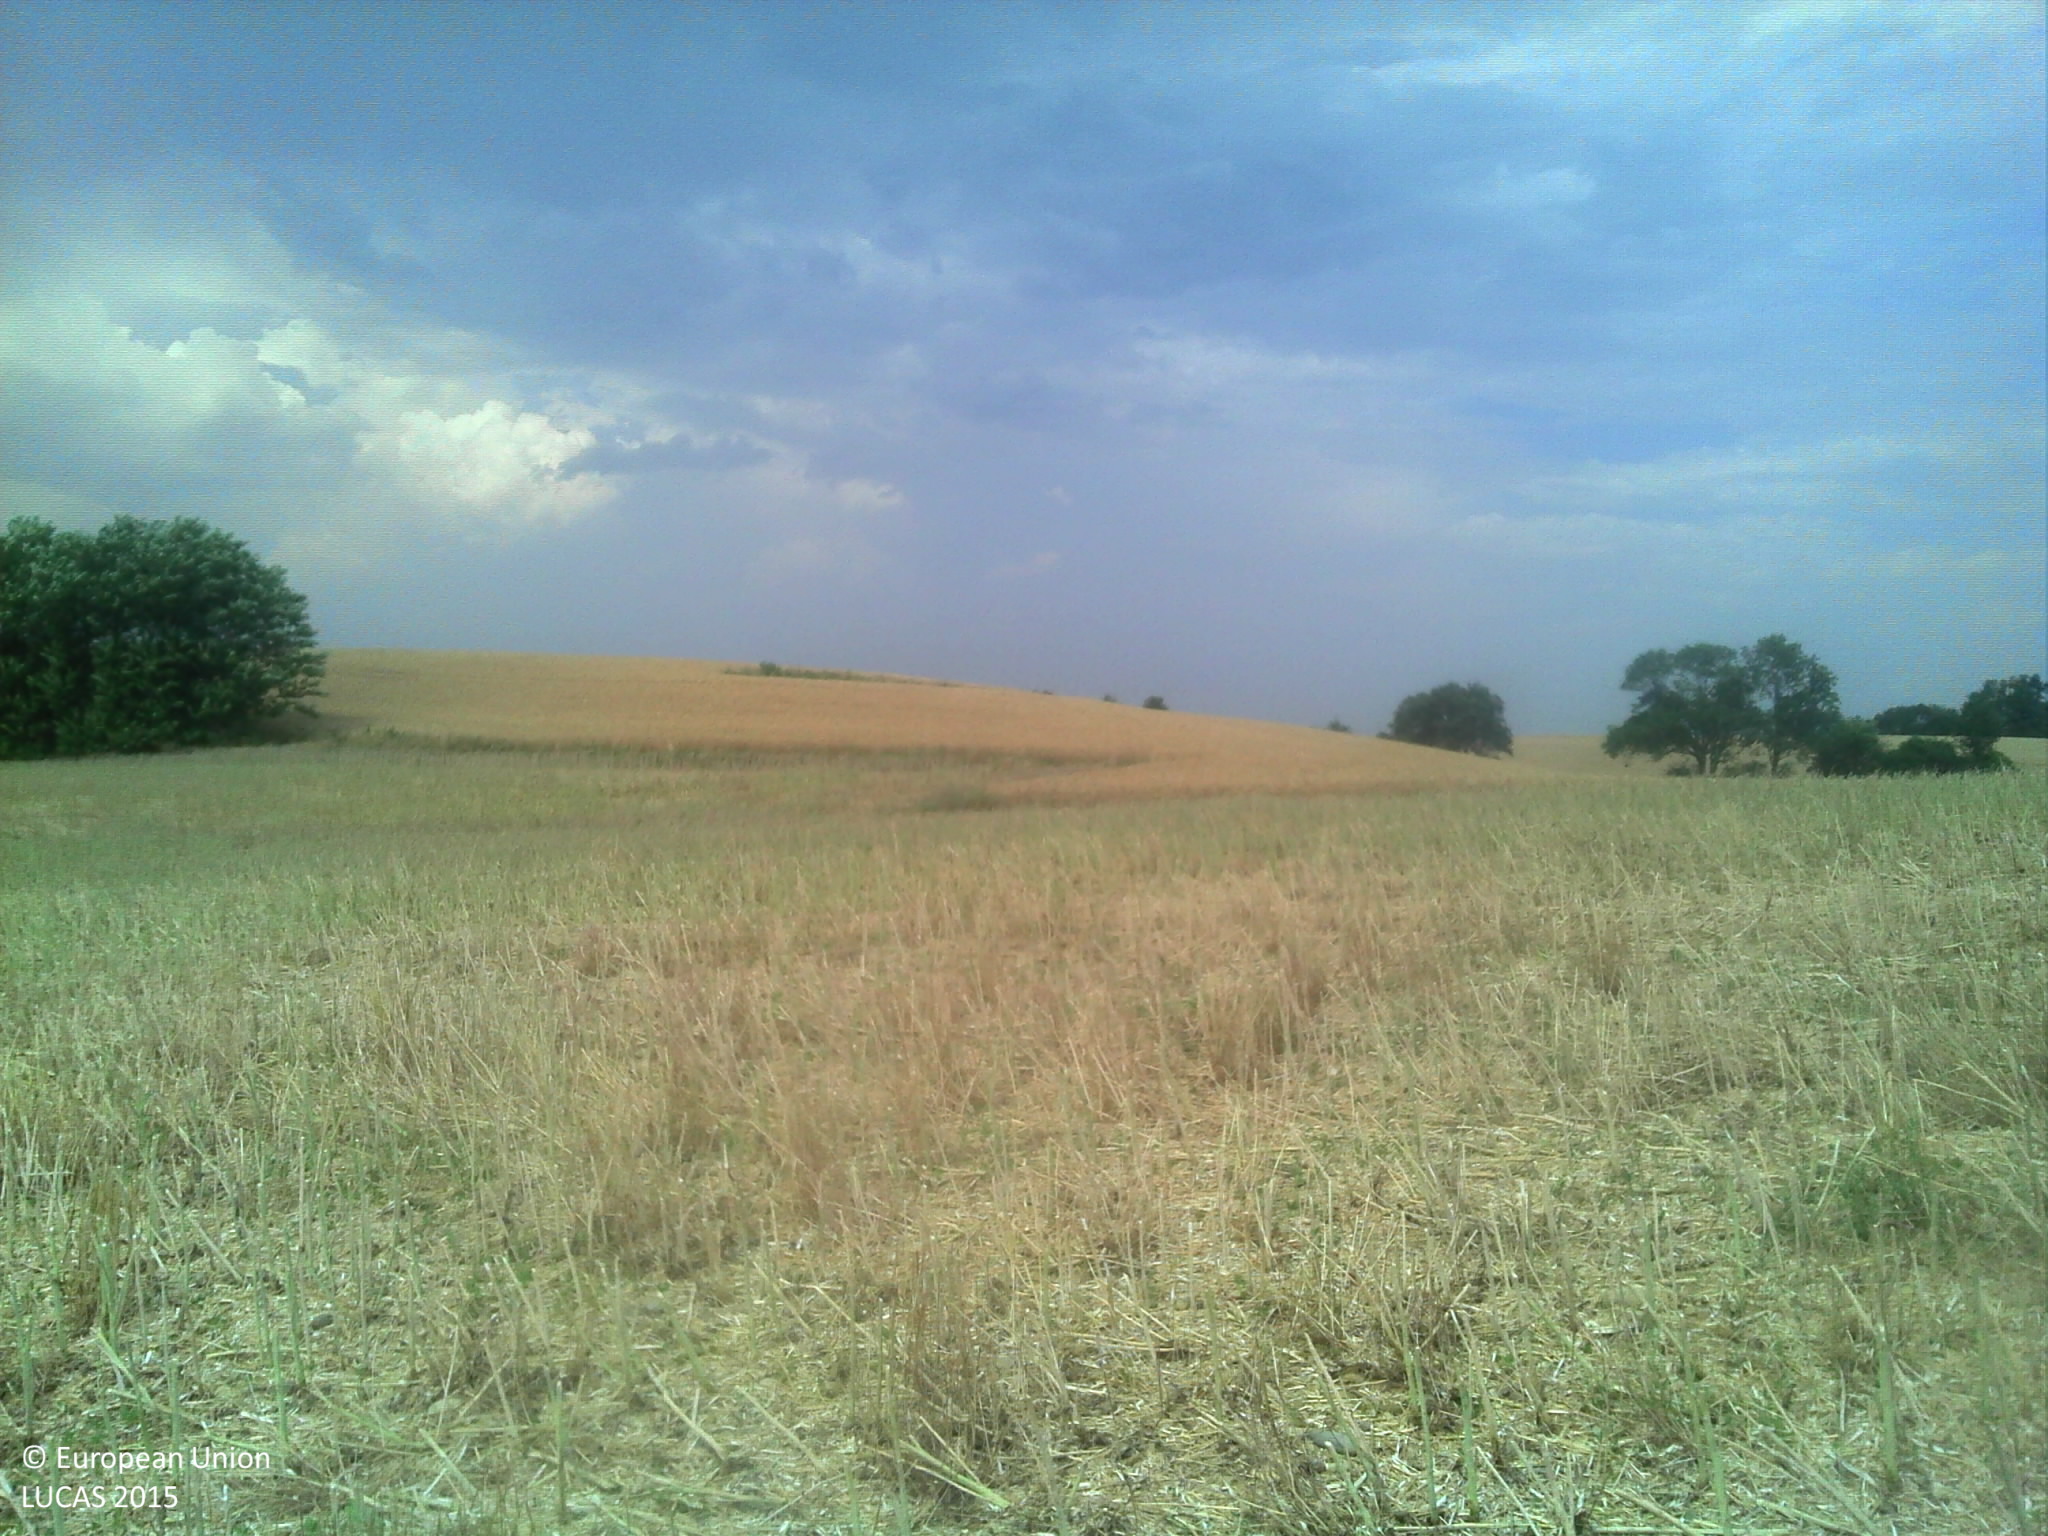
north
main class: Cropland
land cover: Rape and turnip rape
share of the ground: > 75 %
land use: Agriculture (excluding fallow land and kitchen gardens)
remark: Harvested field
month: July
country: FR
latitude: 45.5554
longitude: 5.1493
